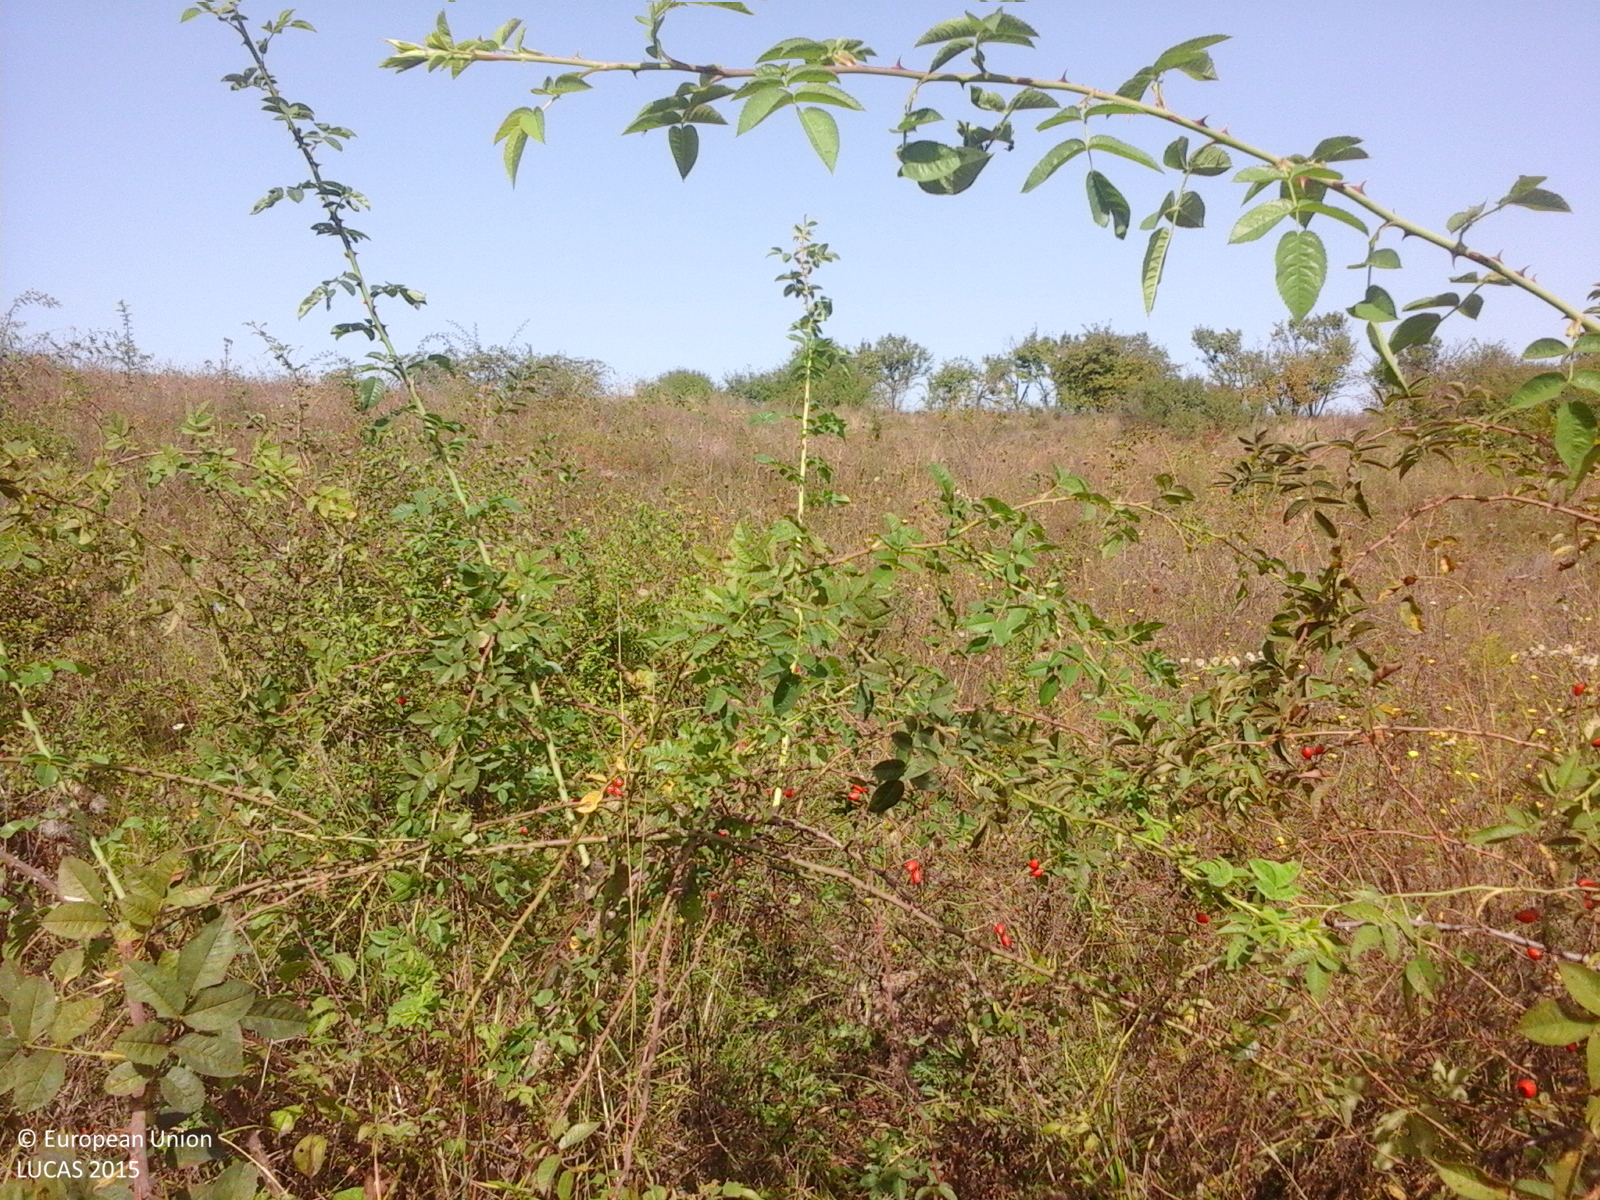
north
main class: Shrubland
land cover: Shrubland without tree cover
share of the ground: > 75 %
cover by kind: shrubs 100 %
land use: Semi-natural and natural areas not in use
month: September
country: RO
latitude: 47.0959
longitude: 23.7916
